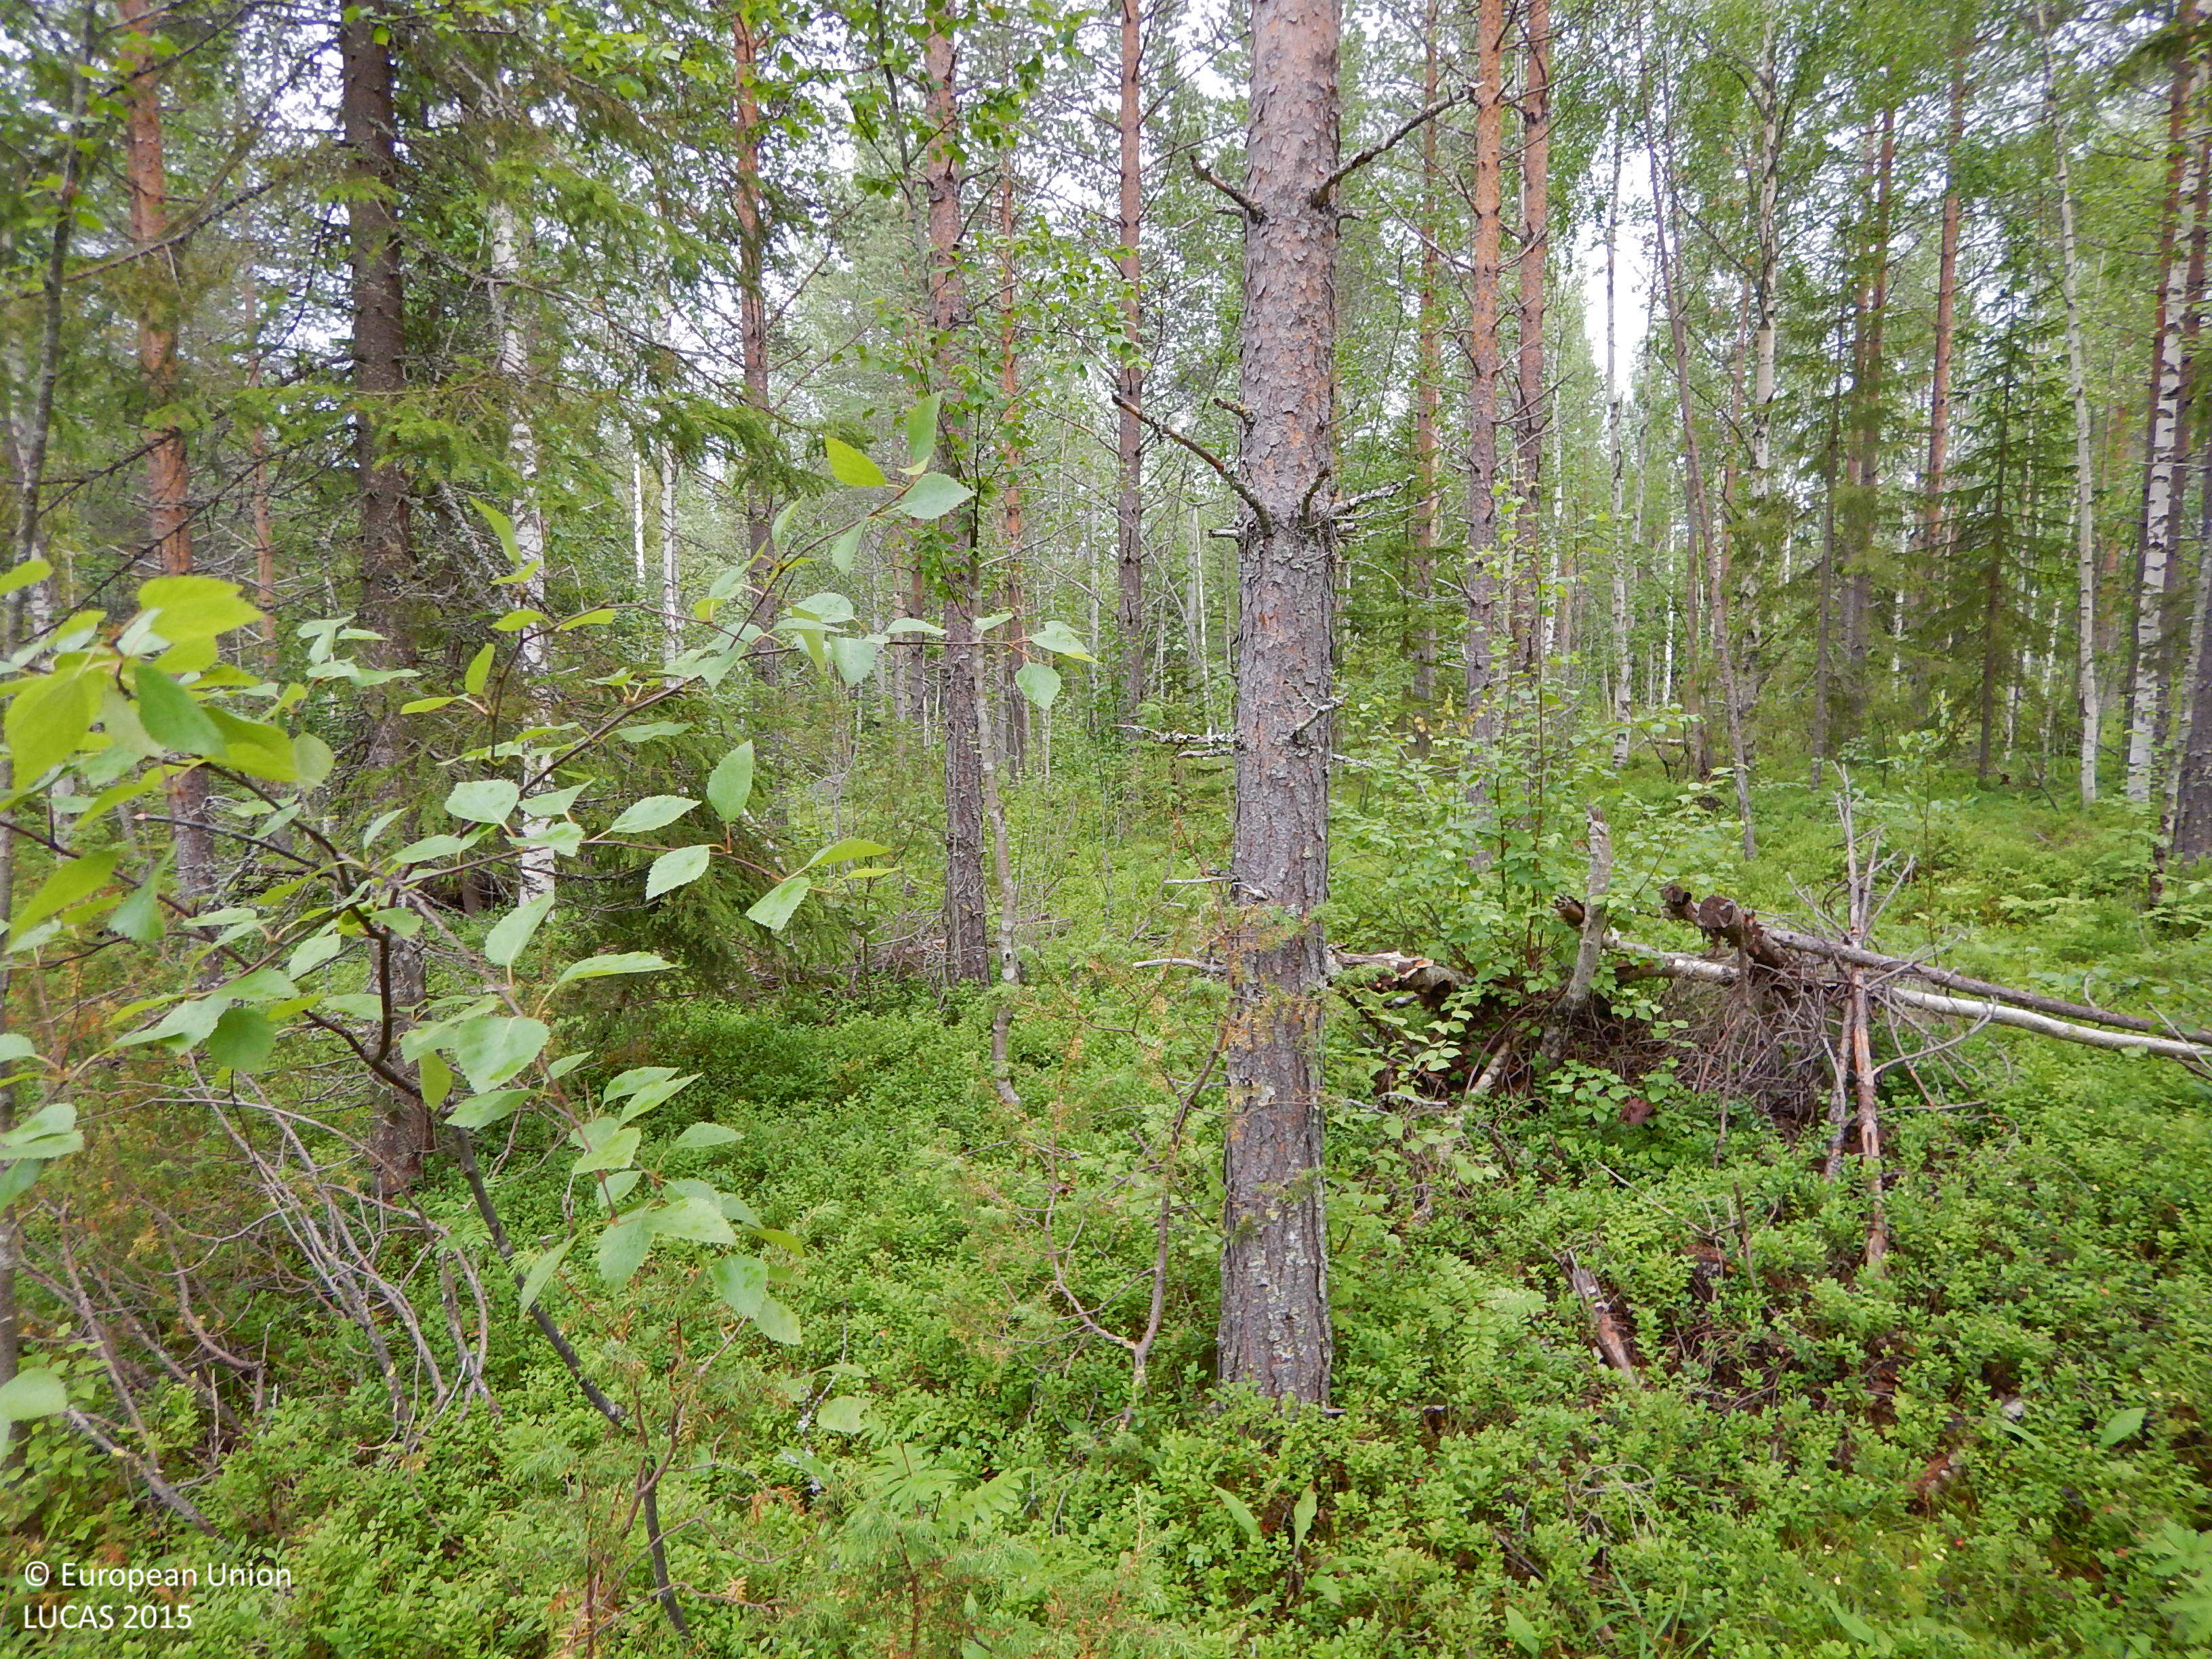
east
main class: Woodland
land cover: Pine dominated mixed woodland
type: boreal forest
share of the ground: 25 - 50 %
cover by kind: shrubs 35 %, coniferous forest trees 30 %, herbaceous plants 15 %, broadleaved forest trees 10 %, lichens and mosses 10 %
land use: Forestry
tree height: > 5 m
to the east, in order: Pine dominated mixed woodland; Tracks; Pine dominated mixed woodland; Tracks; Other mixed woodland; Ditches and canals; Pine dominated mixed woodland; Other coniferous woodland
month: July
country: SE
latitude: 64.9113
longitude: 20.4353
